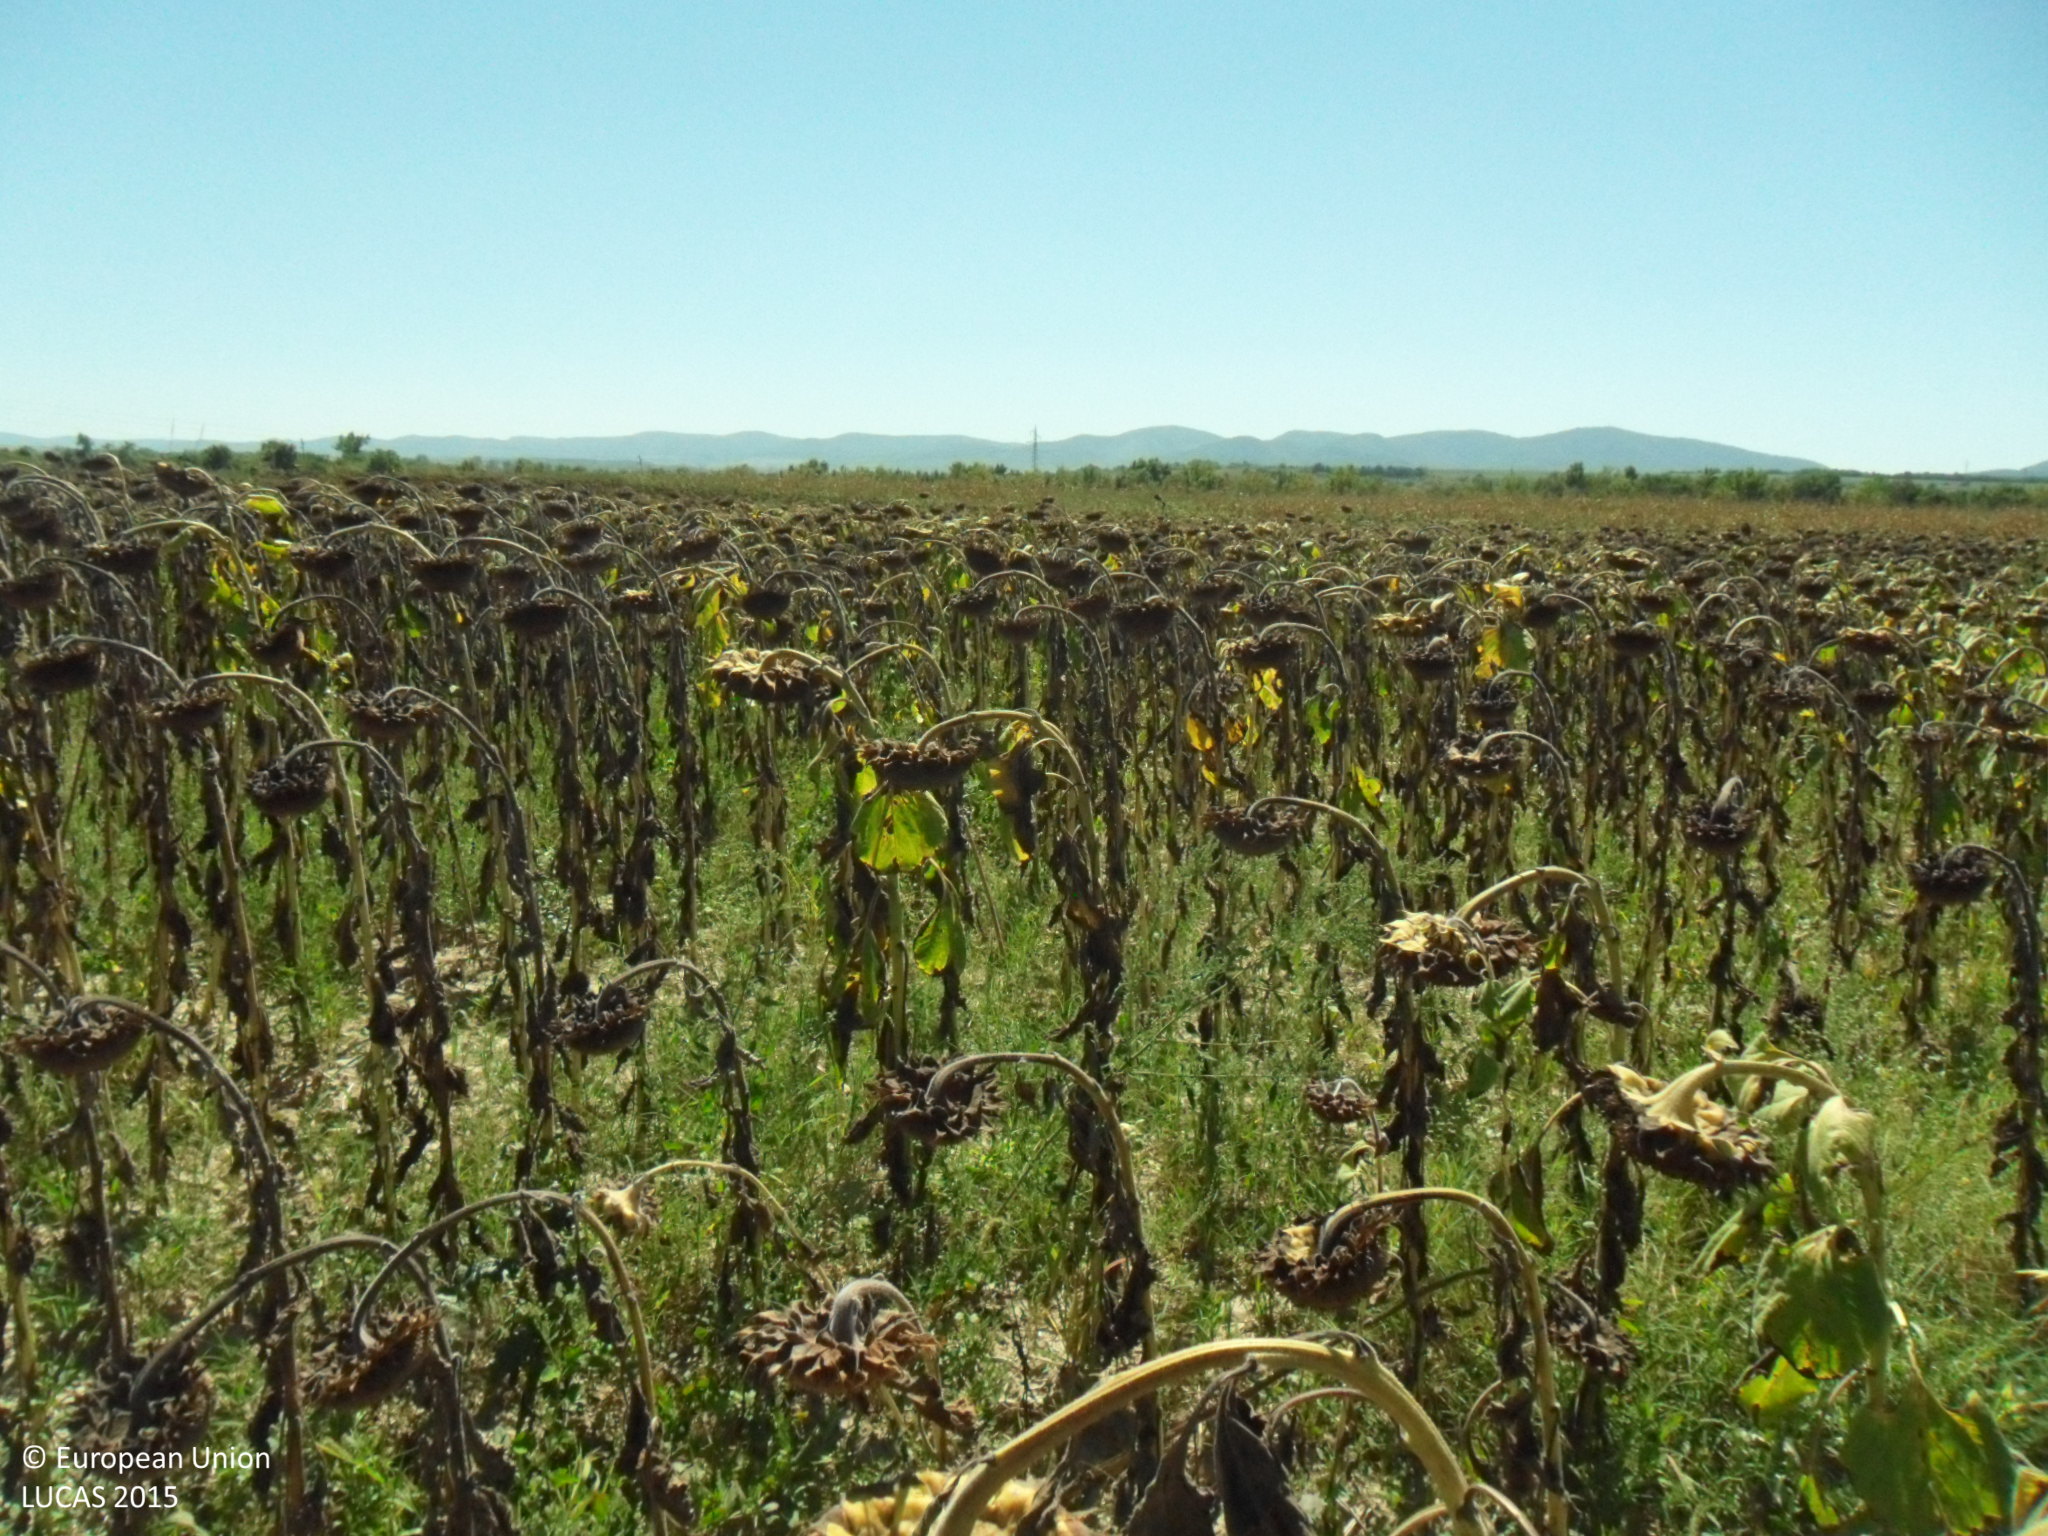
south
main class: Cropland
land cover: Sunflower
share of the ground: 50 - 75 %
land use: Agriculture (excluding fallow land and kitchen gardens)
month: September
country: BG
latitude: 43.1982
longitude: 26.8590
